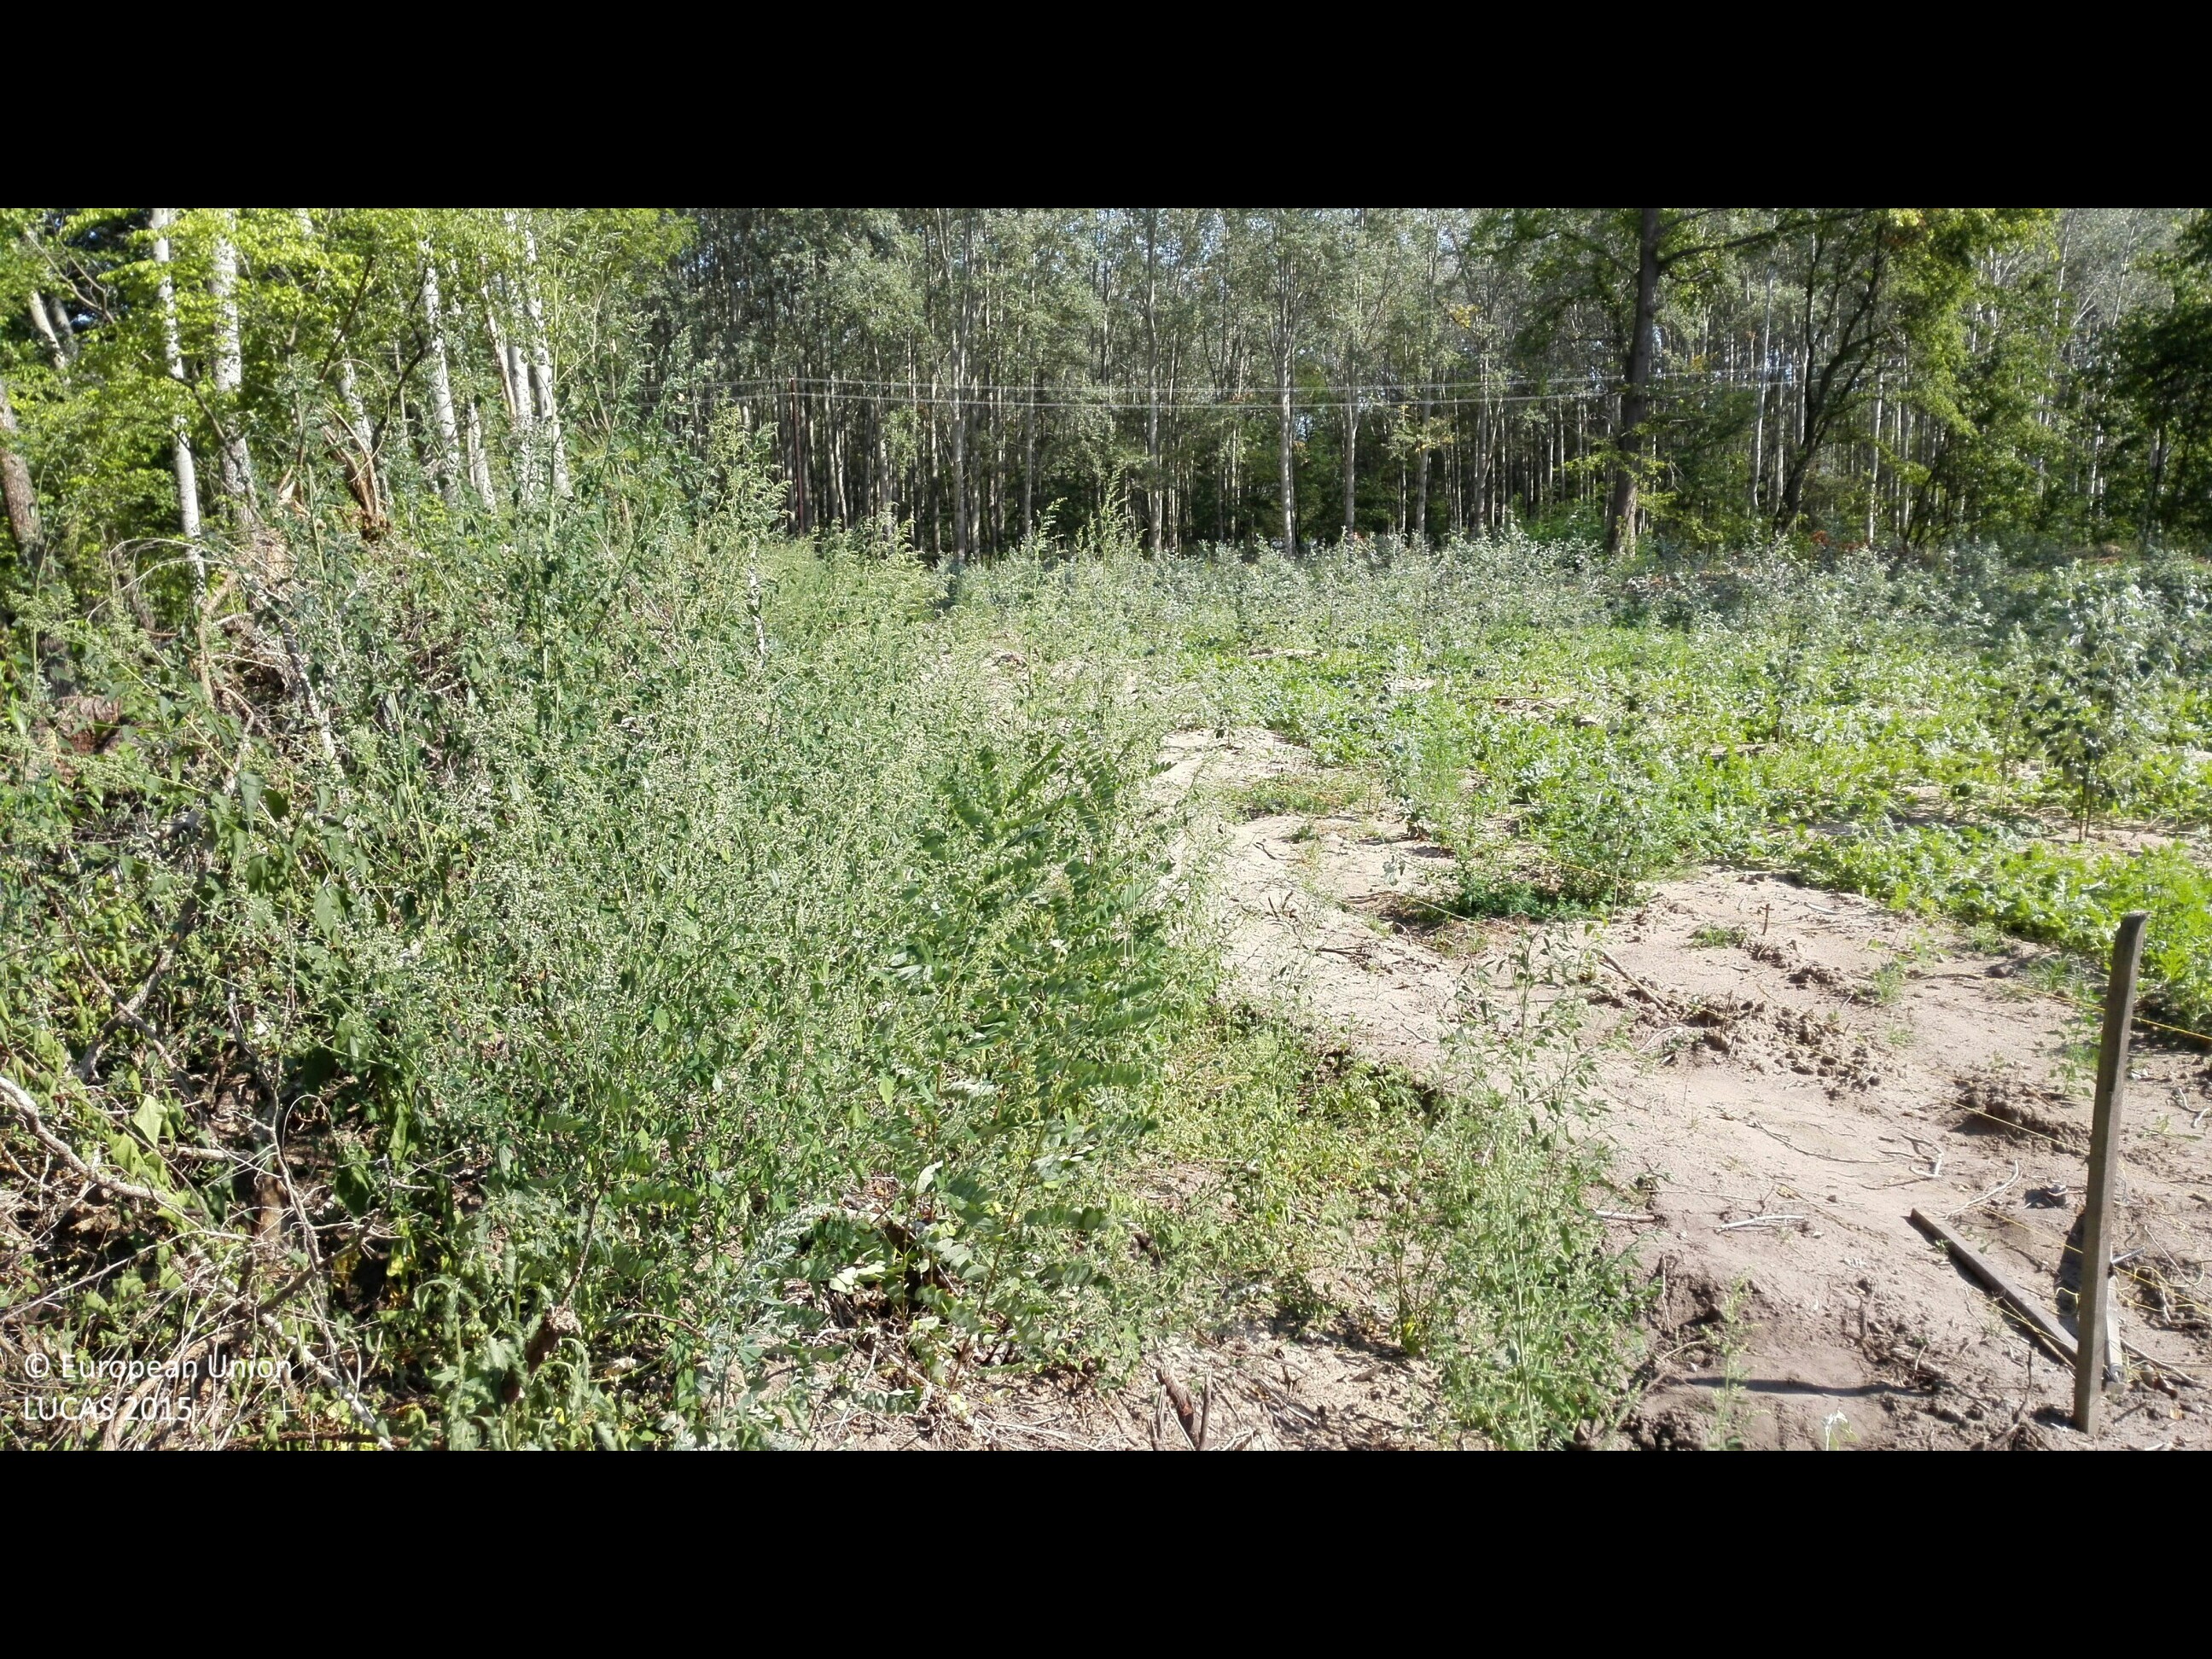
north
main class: Woodland
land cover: Broadleaved woodland
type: non-riverine alder, birch or aspen forest
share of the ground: > 75 %
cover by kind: broadleaved forest trees 80 %, herbaceous plants 15 %, shrubs 5 %
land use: Forestry
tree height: > 5 m
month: August
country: HU
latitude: 47.5055
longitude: 21.7158
